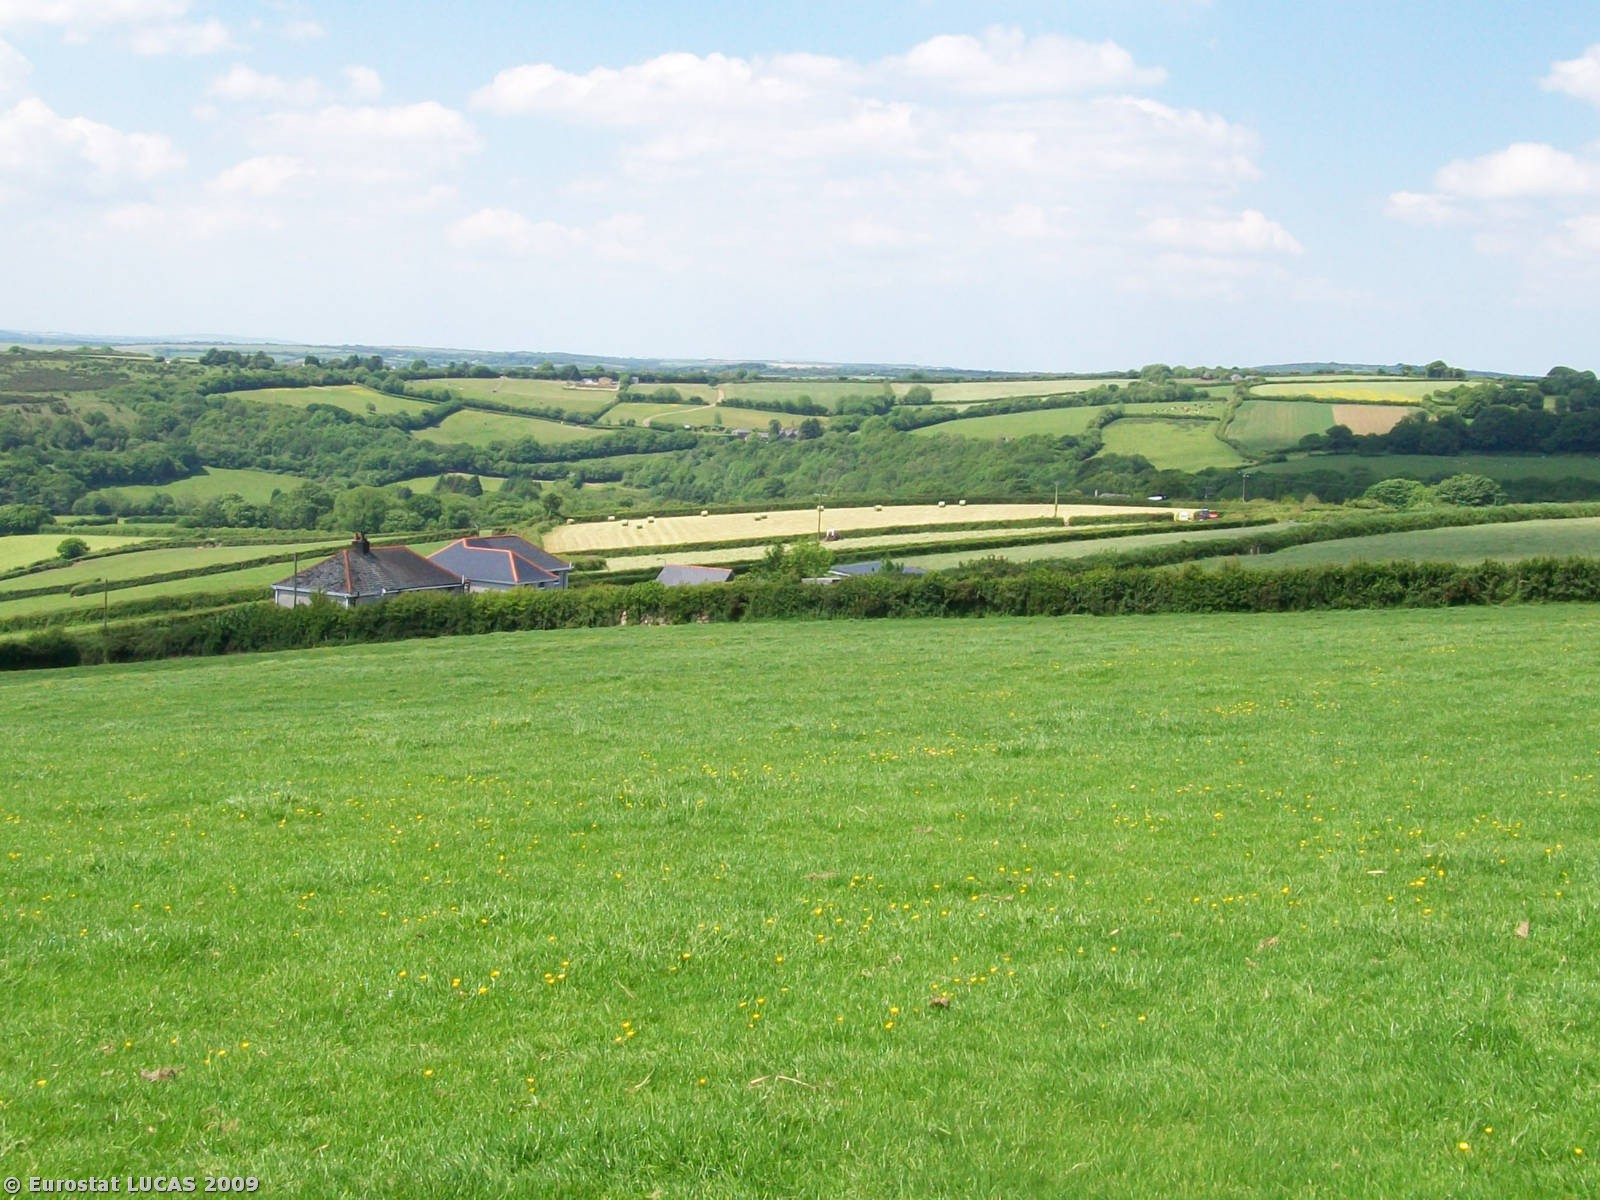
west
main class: Grassland
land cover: Grassland without tree/shrub cover
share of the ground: > 75 %
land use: Agriculture (excluding fallow land and kitchen gardens)
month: June
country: GB
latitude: 50.4869
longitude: -4.5523
